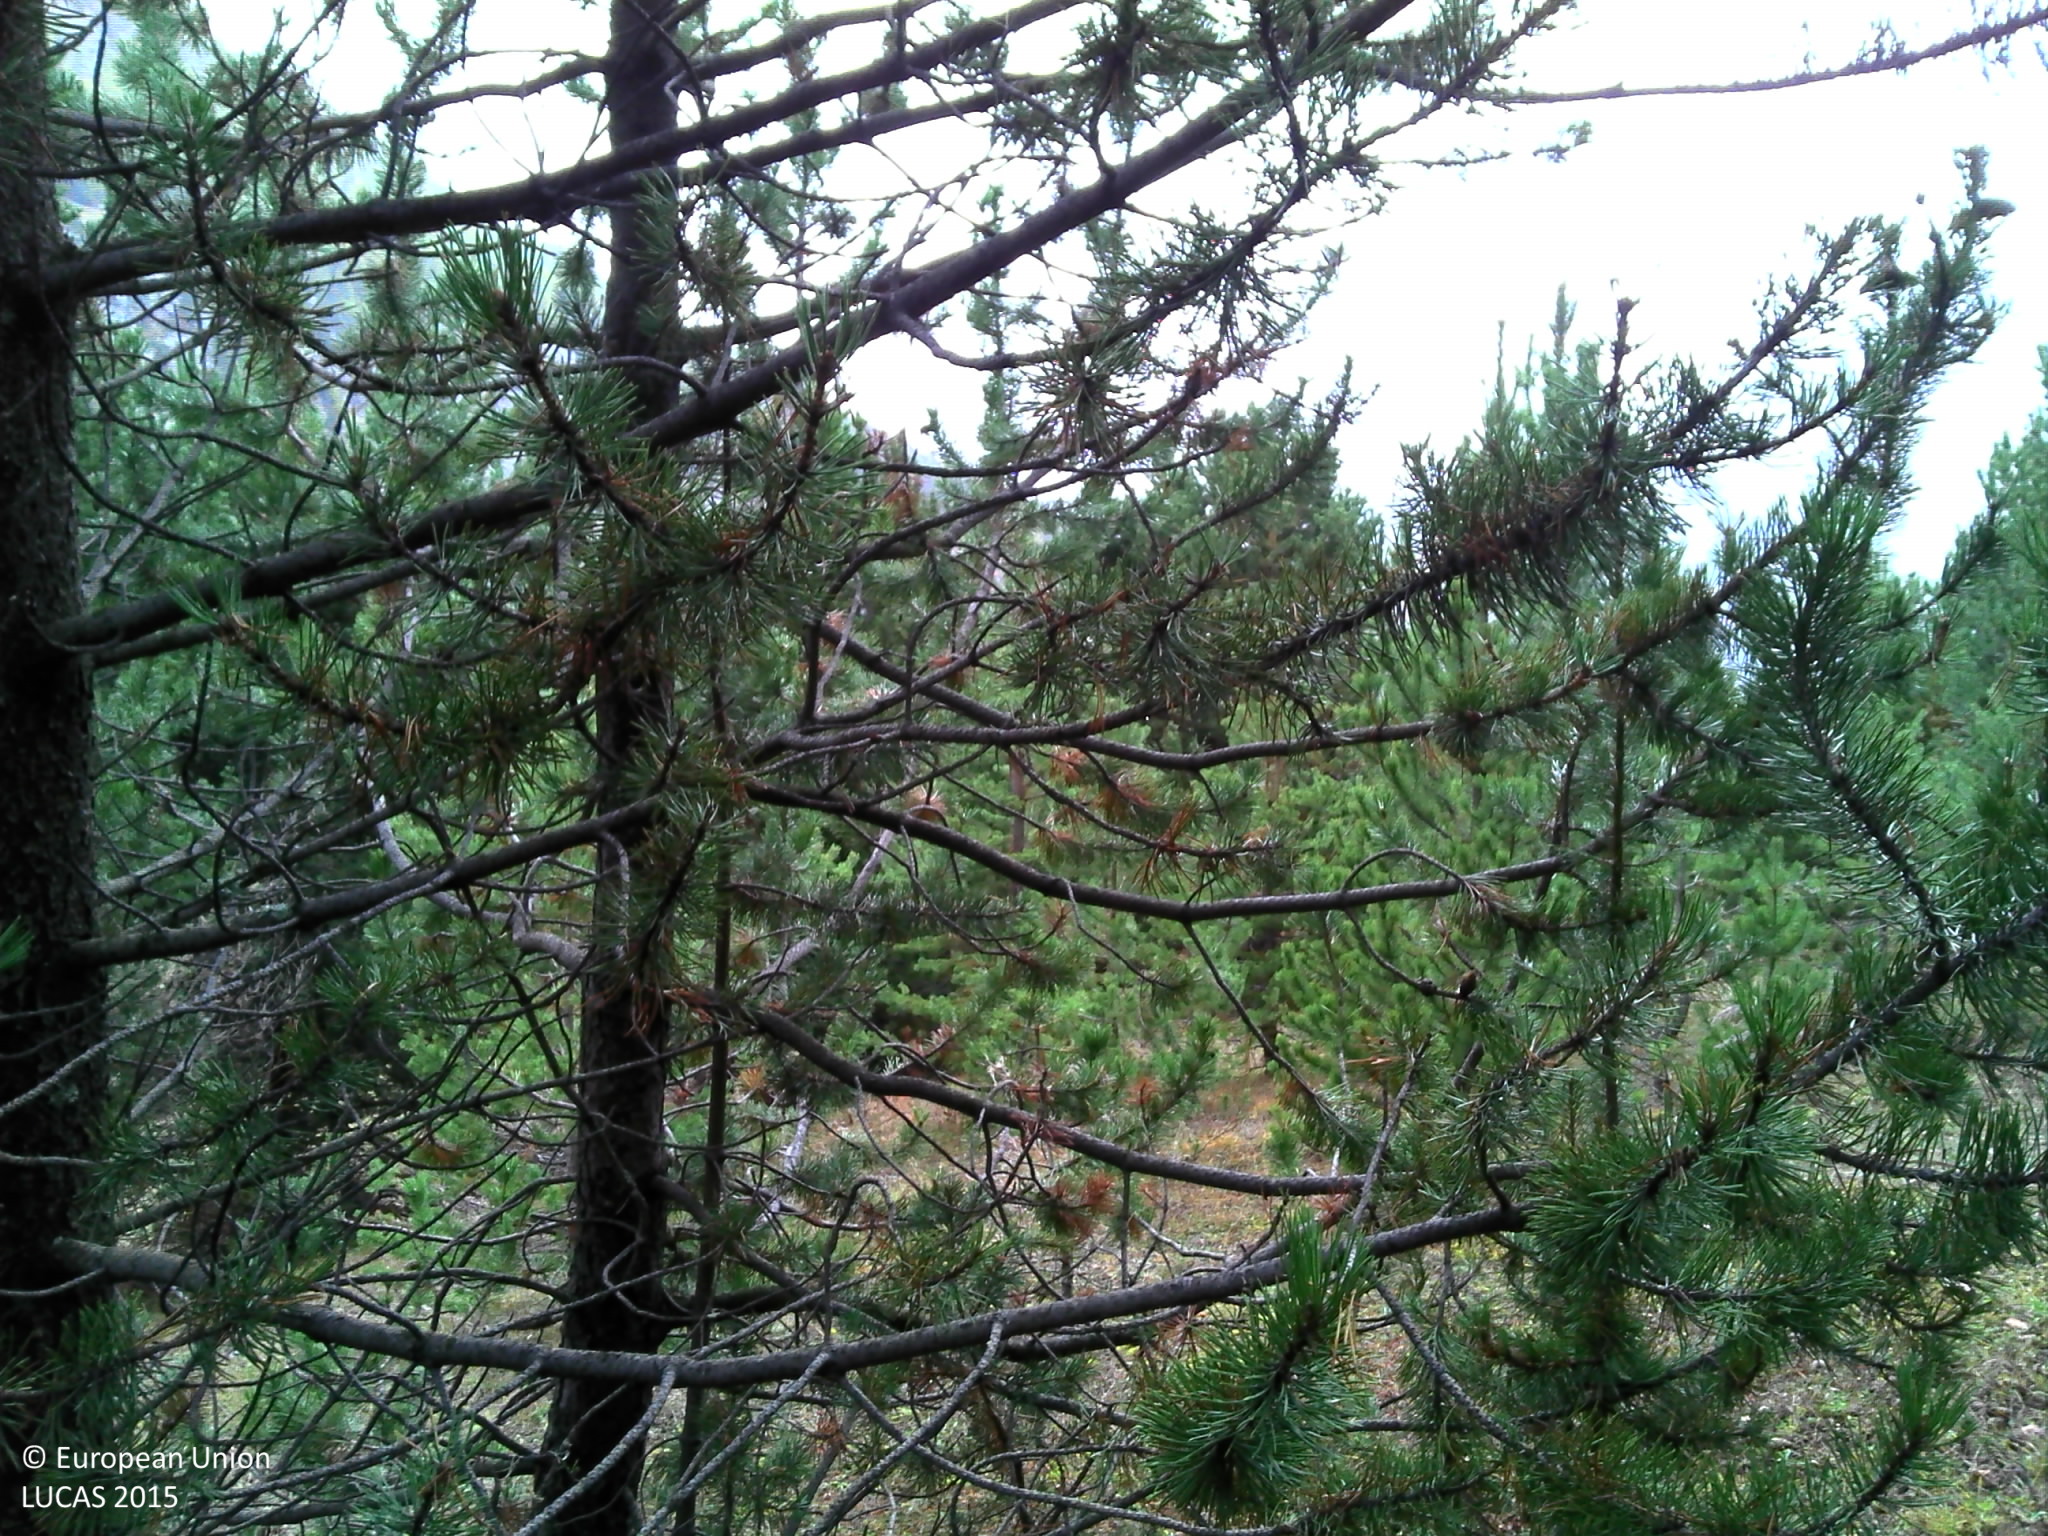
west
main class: Woodland
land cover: Pine dominated coniferous woodland
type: alpine coniferous forest
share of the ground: > 75 %
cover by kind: coniferous forest trees 70 %, herbaceous plants 15 %, consolidated bare surface 15 %
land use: Forestry
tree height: > 5 m
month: October
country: FR
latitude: 44.8584
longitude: 6.7279
